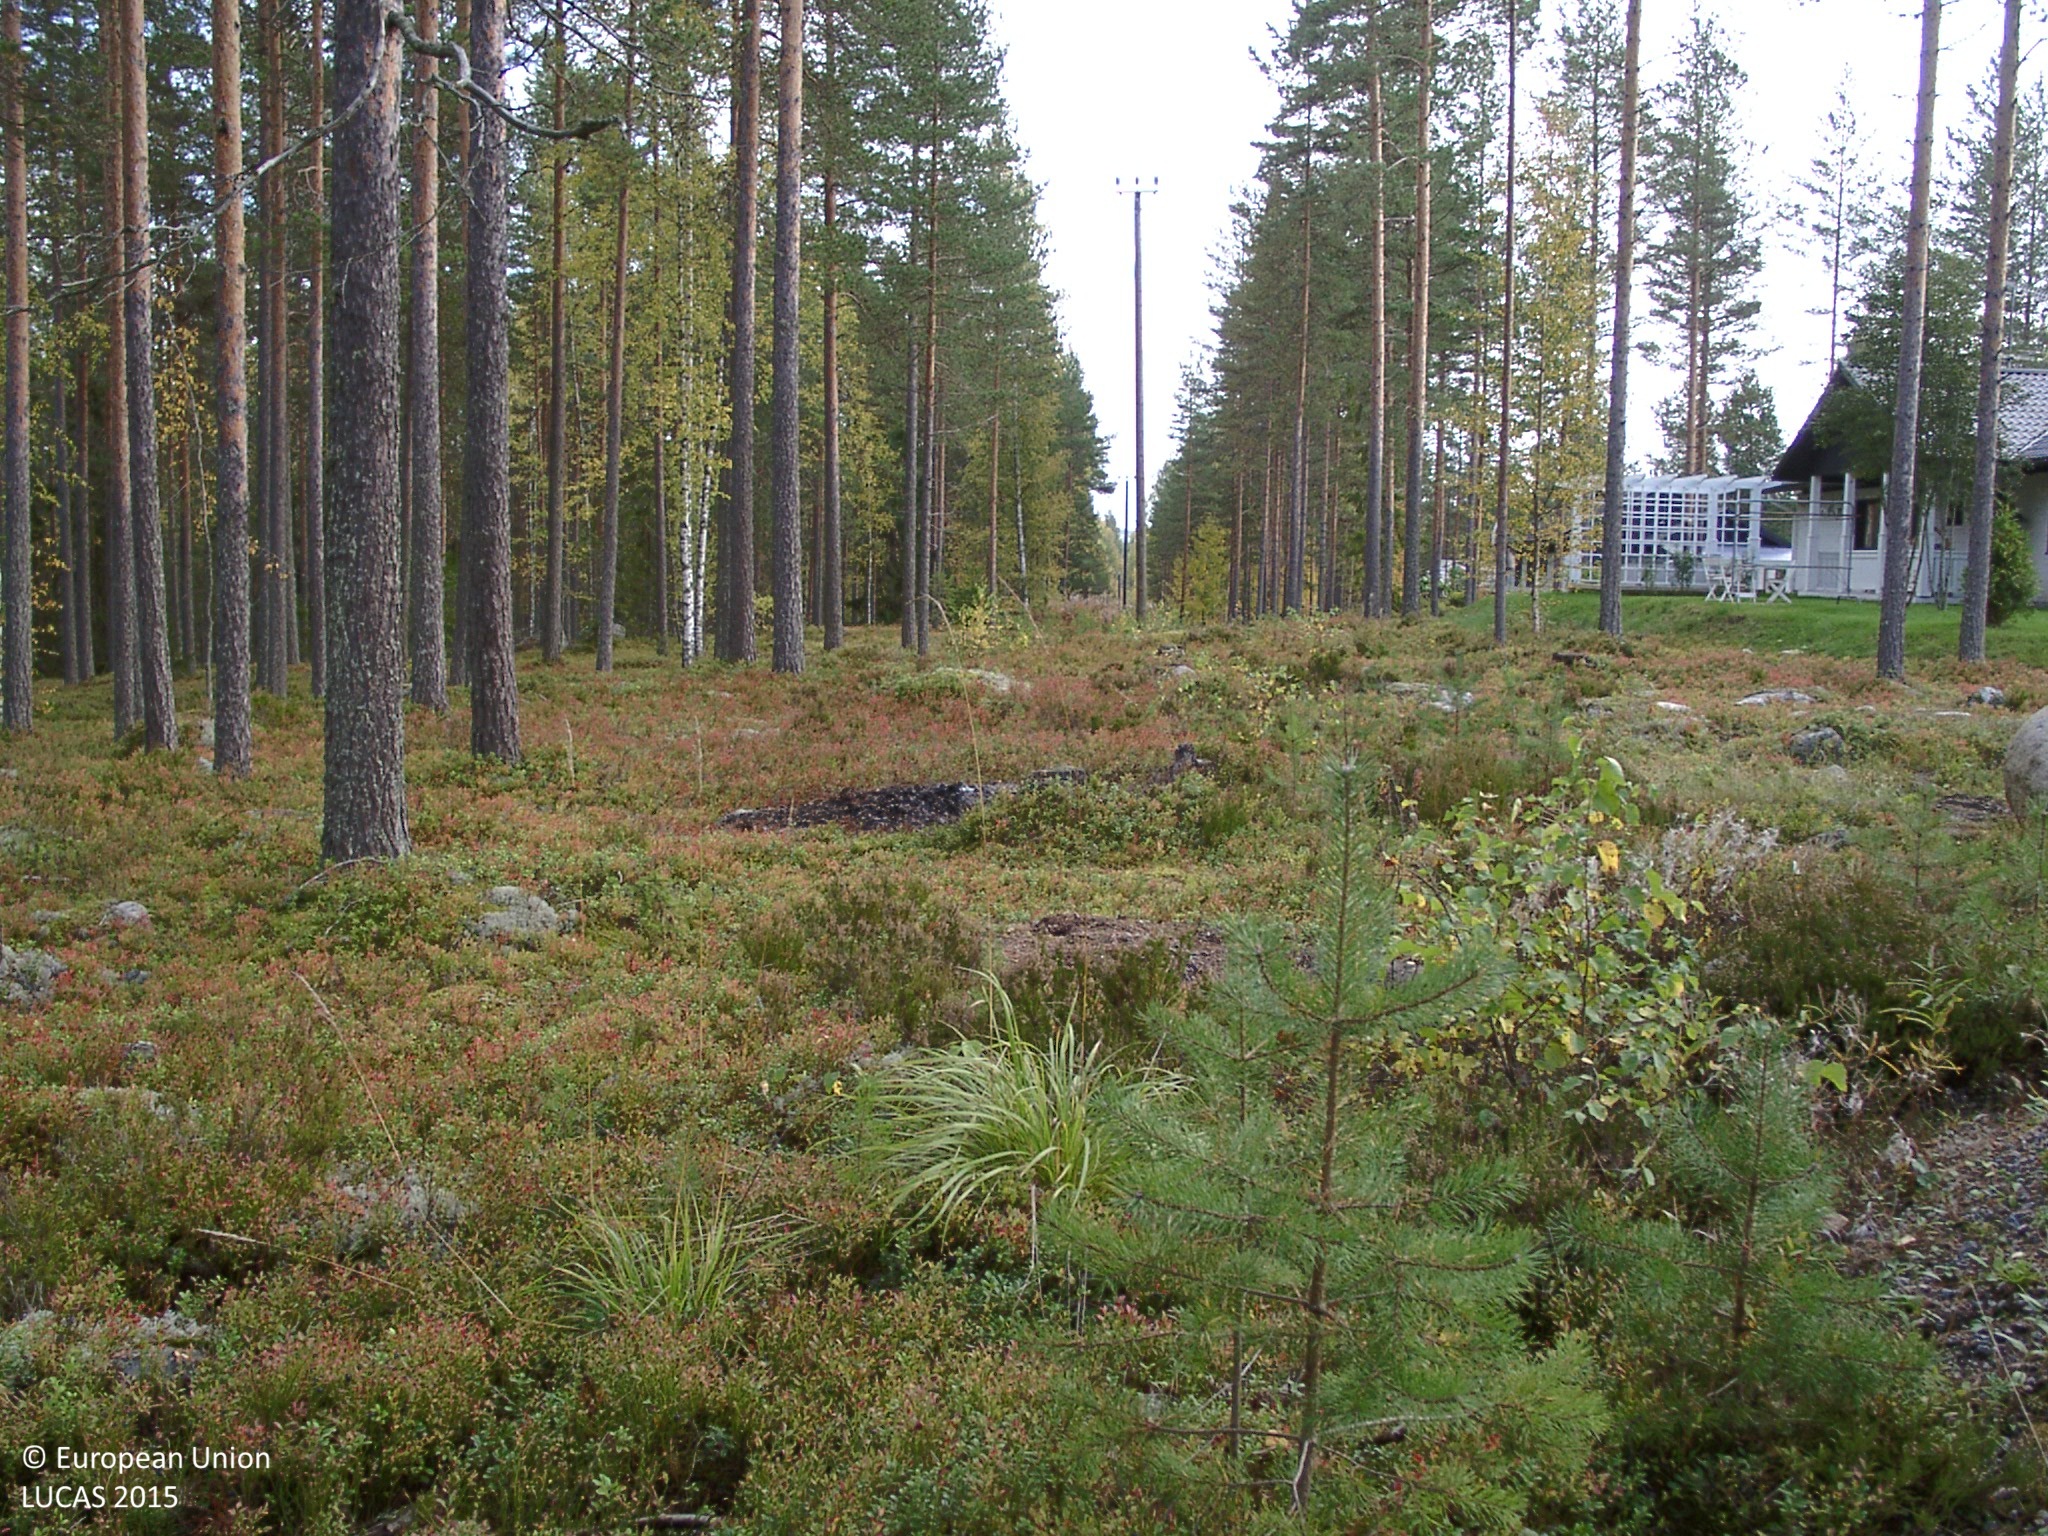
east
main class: Shrubland
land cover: Shrubland without tree cover
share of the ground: > 75 %
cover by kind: shrubs 80 %, lichens and mosses 20 %
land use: Electricity, gas and thermal power distribution
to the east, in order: Shrubland without tree cover; Electric lines; Pine dominated mixed woodland; Pine dominated coniferous woodland; Other coniferous woodland; Other mixed woodland; Artificial constructions in urban areas
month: September
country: FI
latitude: 62.6837
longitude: 25.3618
